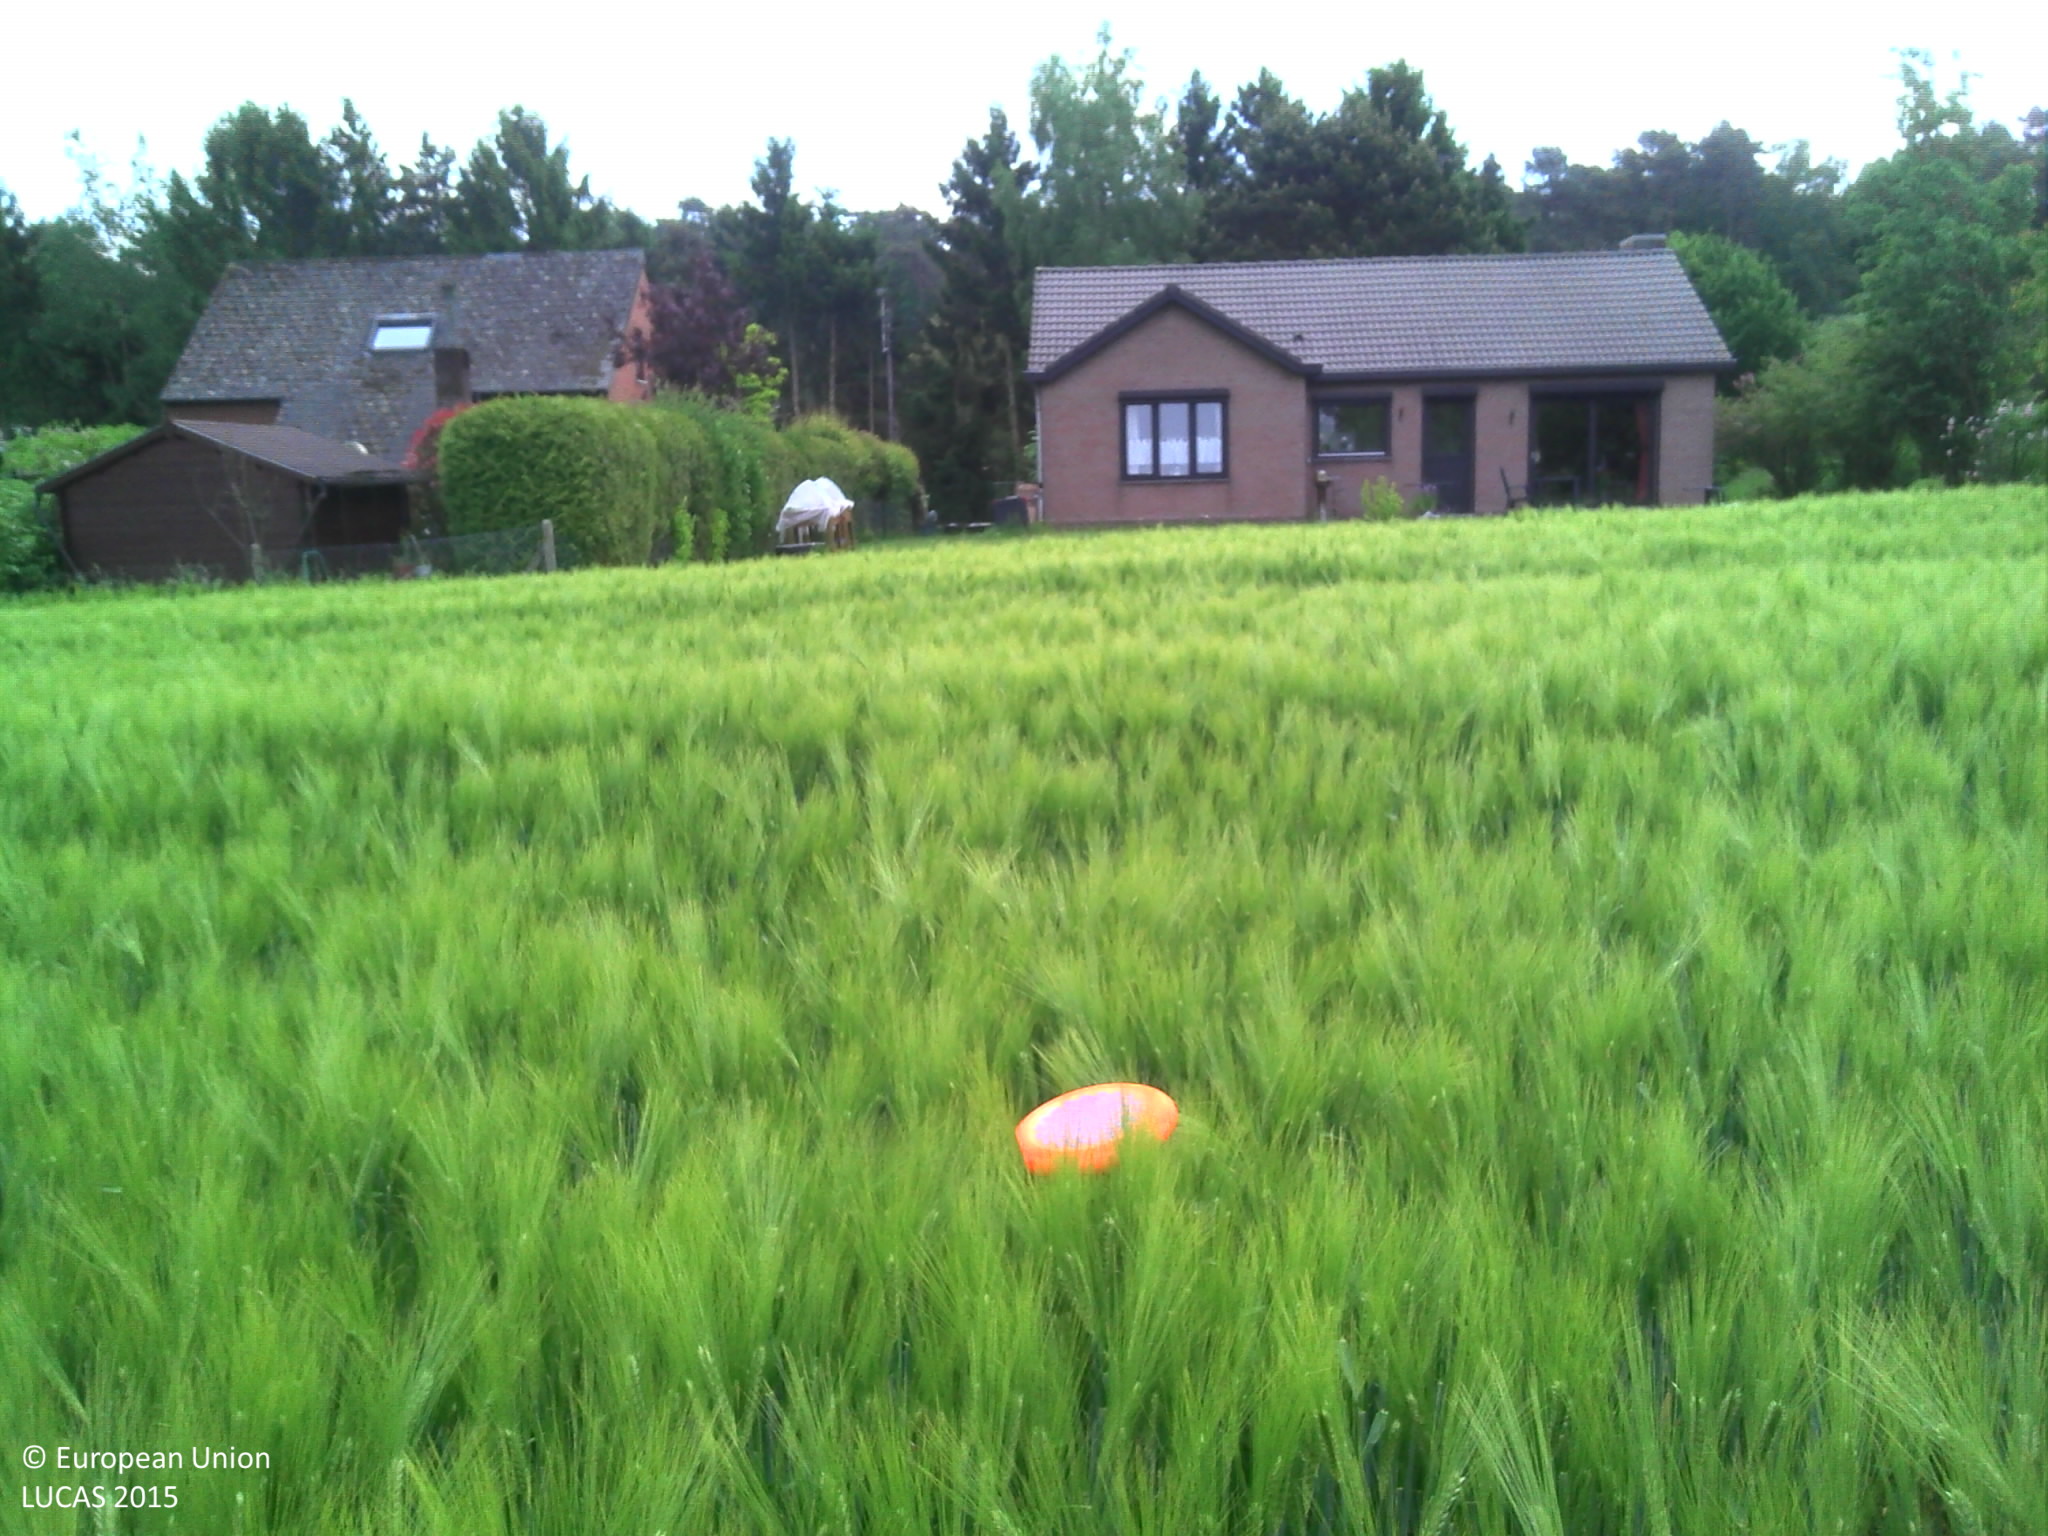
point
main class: Cropland
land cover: Barley
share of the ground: > 75 %
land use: Agriculture (excluding fallow land and kitchen gardens)
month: May
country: BE
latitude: 50.6129
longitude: 4.5551
